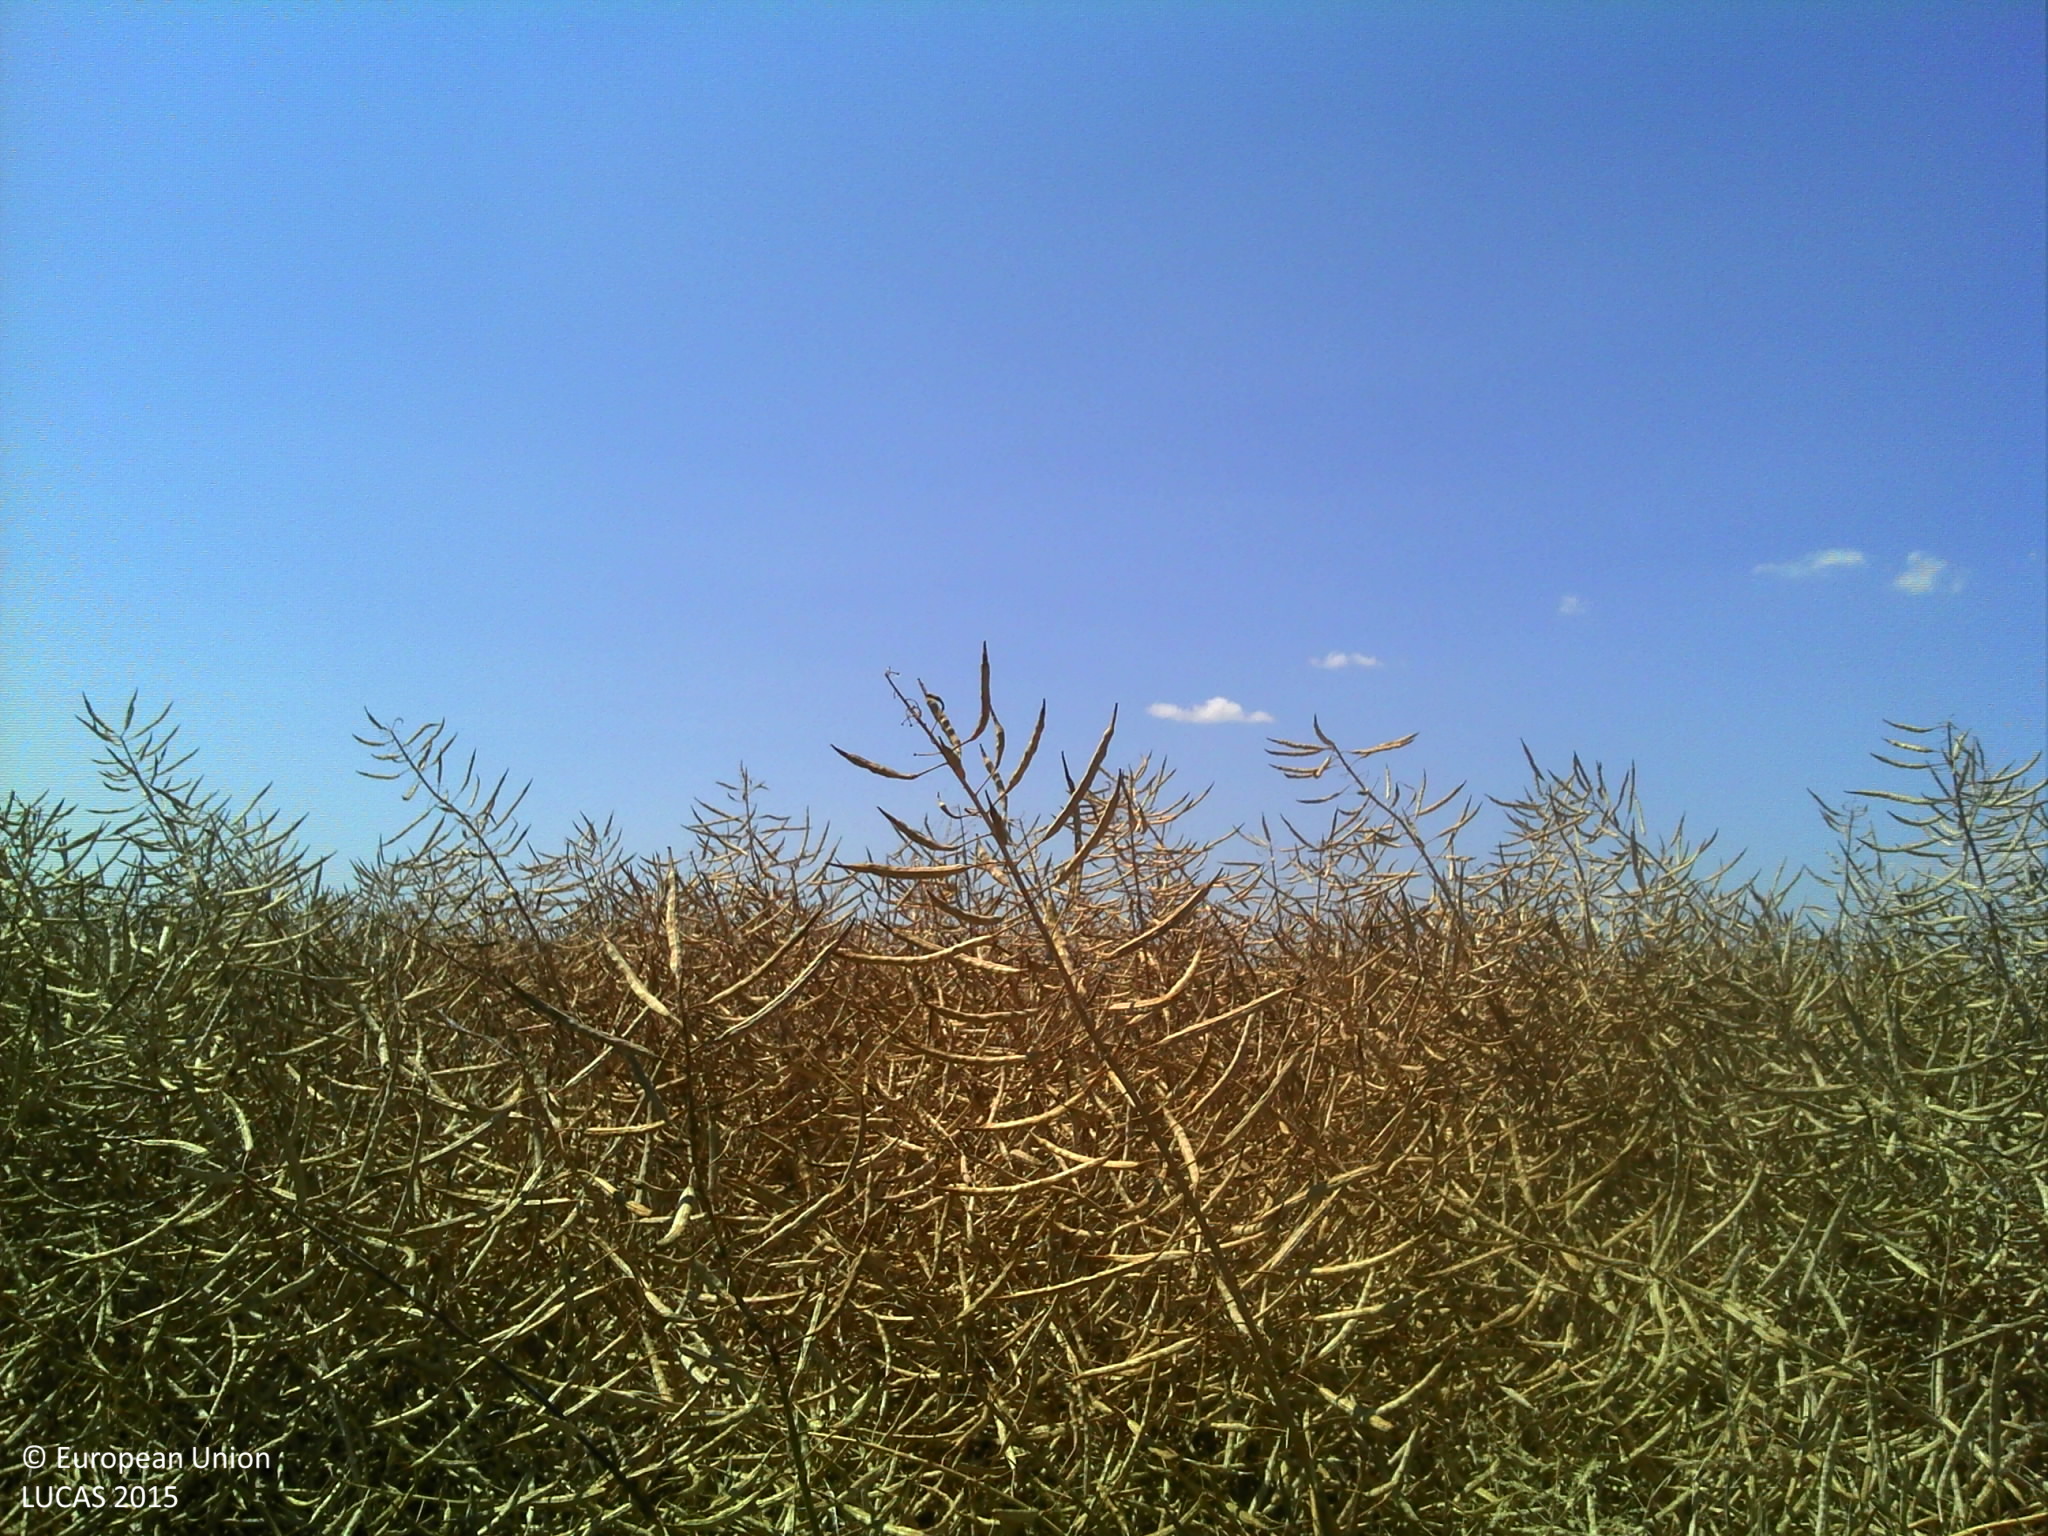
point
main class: Cropland
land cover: Rape and turnip rape
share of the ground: > 75 %
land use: Agriculture (excluding fallow land and kitchen gardens)
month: July
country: FR
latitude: 47.9184
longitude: 0.6783
